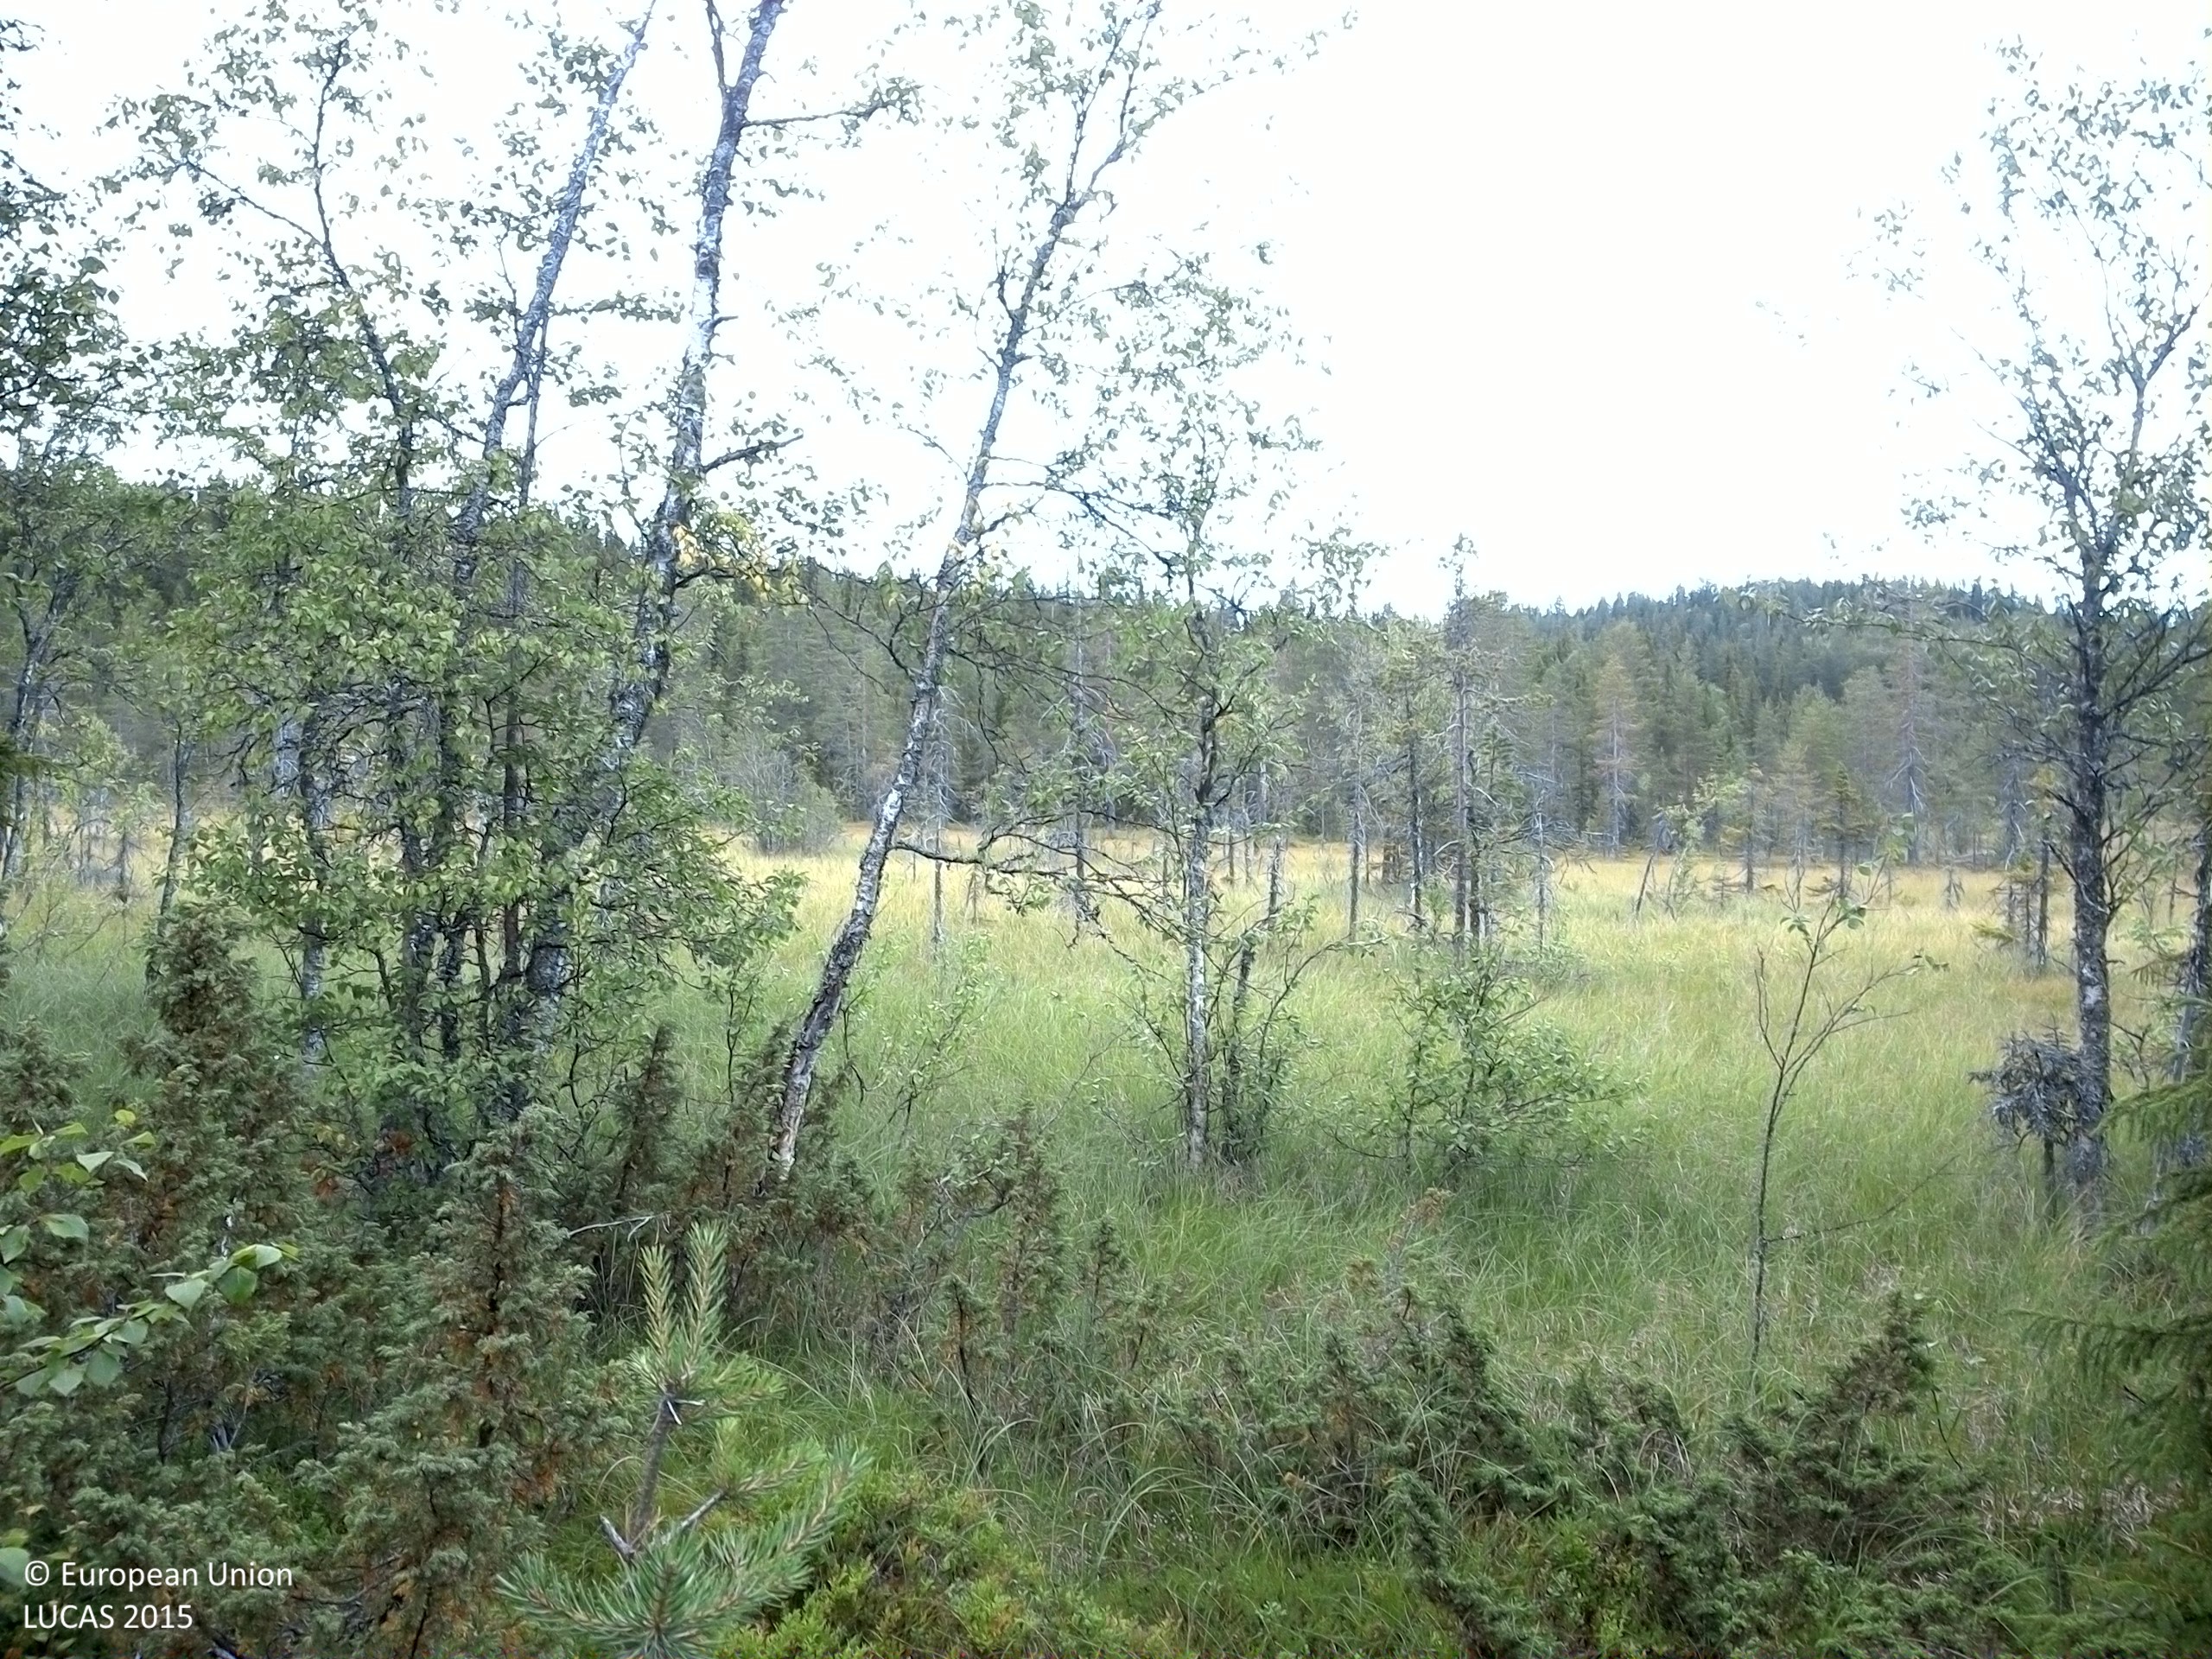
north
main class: Woodland
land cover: Pine dominated mixed woodland
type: boreal forest
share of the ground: 50 - 75 %
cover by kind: coniferous forest trees 45 %, shrubs 30 %, broadleaved forest trees 15 %, herbaceous plants 5 %, lichens and mosses 5 %
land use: Forestry
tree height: < 5 m
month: August
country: SE
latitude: 63.8928
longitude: 17.8949
